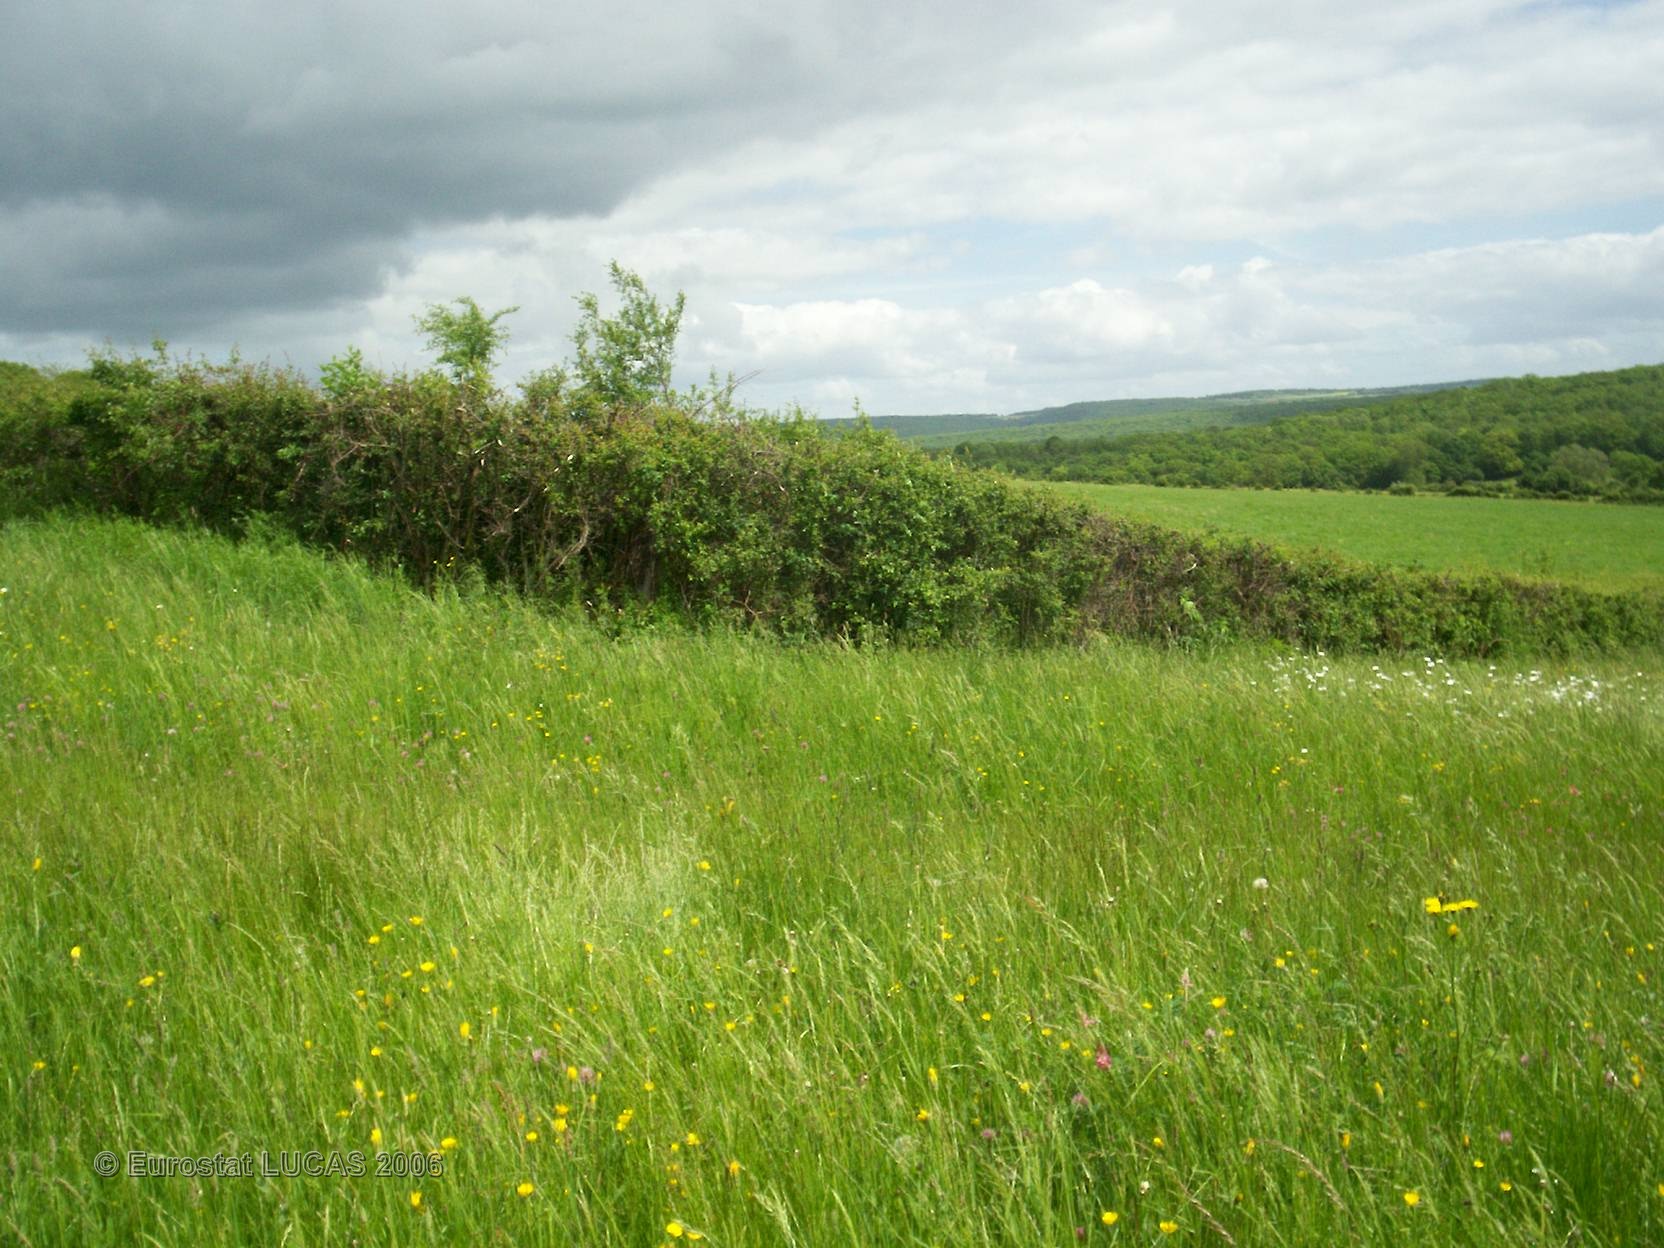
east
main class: Grassland
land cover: Grassland without tree/shrub cover
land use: Agriculture (excluding fallow land and kitchen gardens)
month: May
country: FR
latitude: 47.1382
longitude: 4.6602
